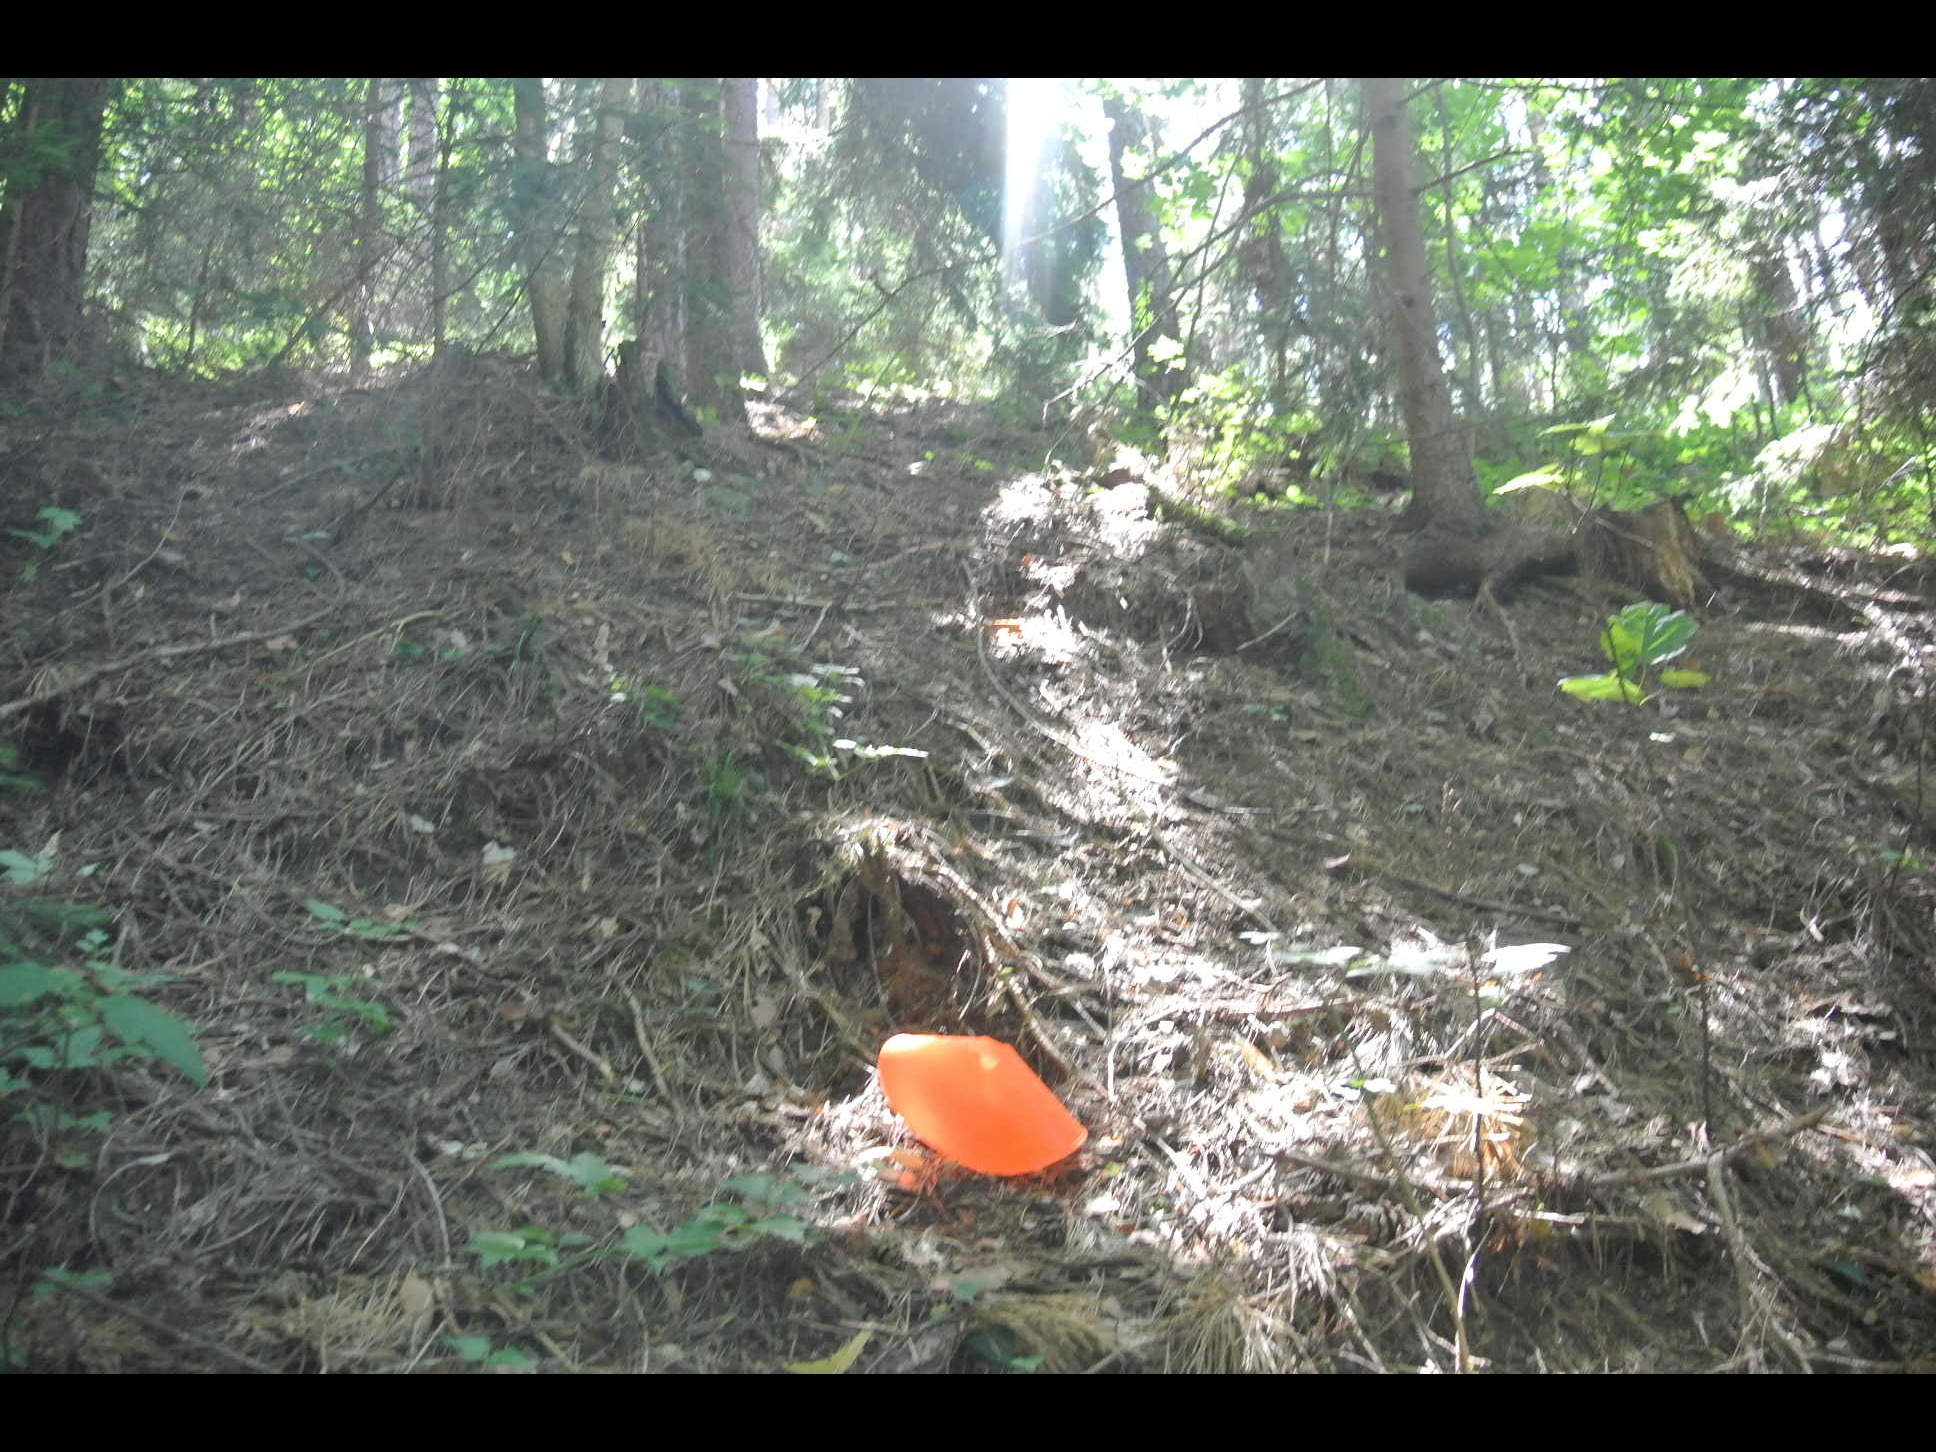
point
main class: Woodland
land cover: Other mixed woodland
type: alpine coniferous forest
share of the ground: > 75 %
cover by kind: coniferous forest trees 70 %, broadleaved forest trees 30 %
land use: Forestry
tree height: > 5 m
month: July
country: AT
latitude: 47.6806
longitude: 16.0103
